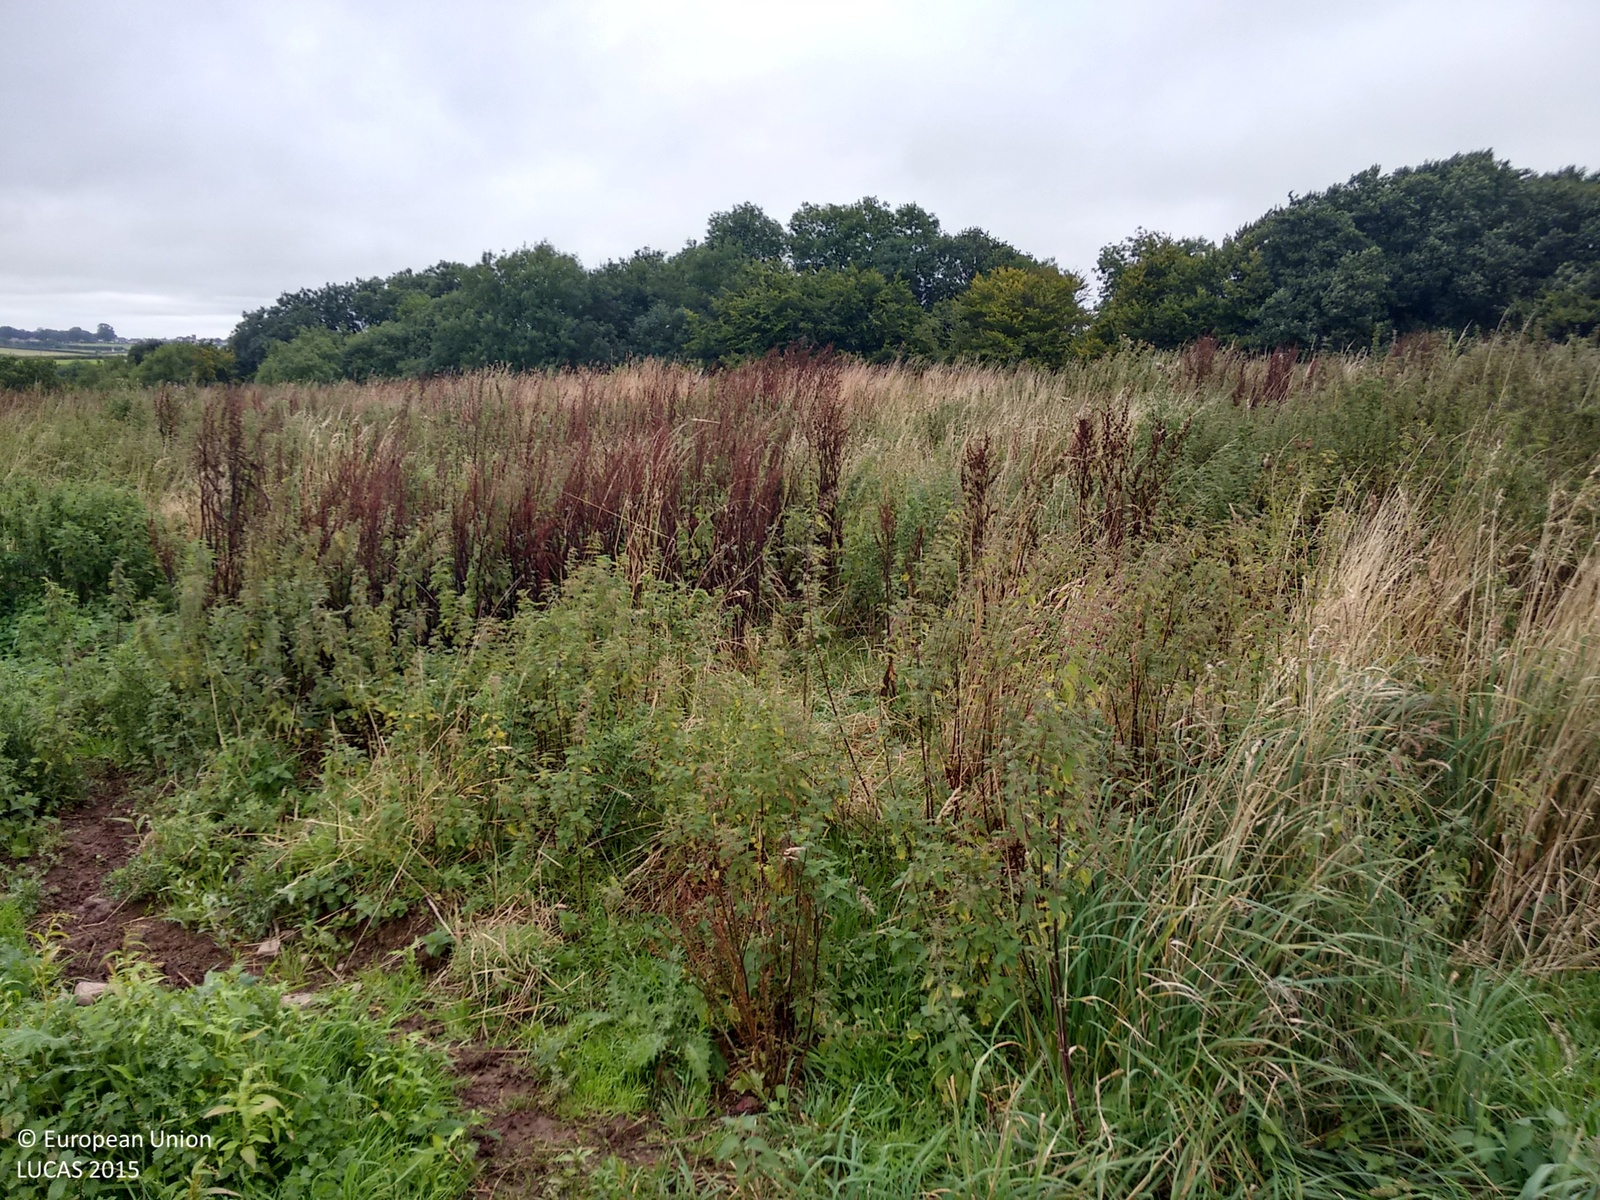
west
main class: Grassland
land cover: Spontaneously vegetated surfaces
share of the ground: > 75 %
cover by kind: herbaceous plants 100 %
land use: Agriculture (excluding fallow land and kitchen gardens)
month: August
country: GB
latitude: 50.8925
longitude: -3.6354
